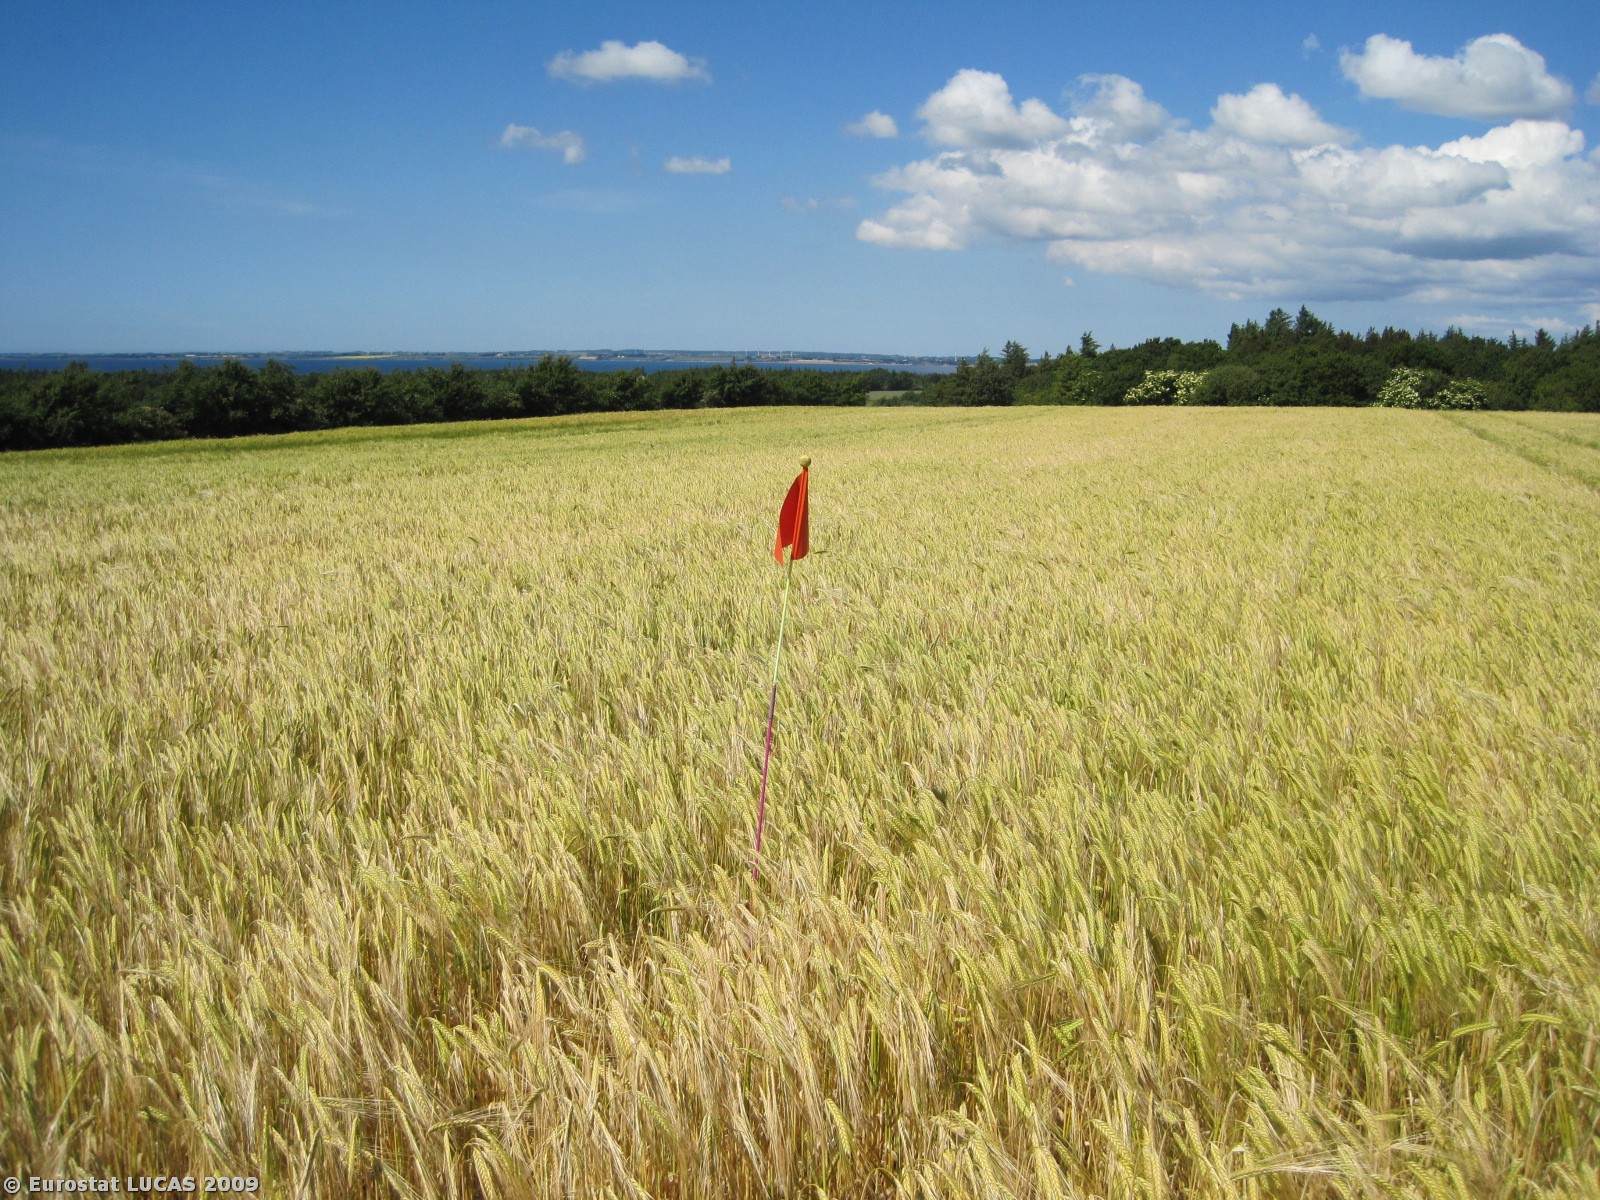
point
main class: Cropland
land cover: Barley
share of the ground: > 75 %
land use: Agriculture (excluding fallow land and kitchen gardens)
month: June
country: DK
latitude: 56.6131
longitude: 8.7470
